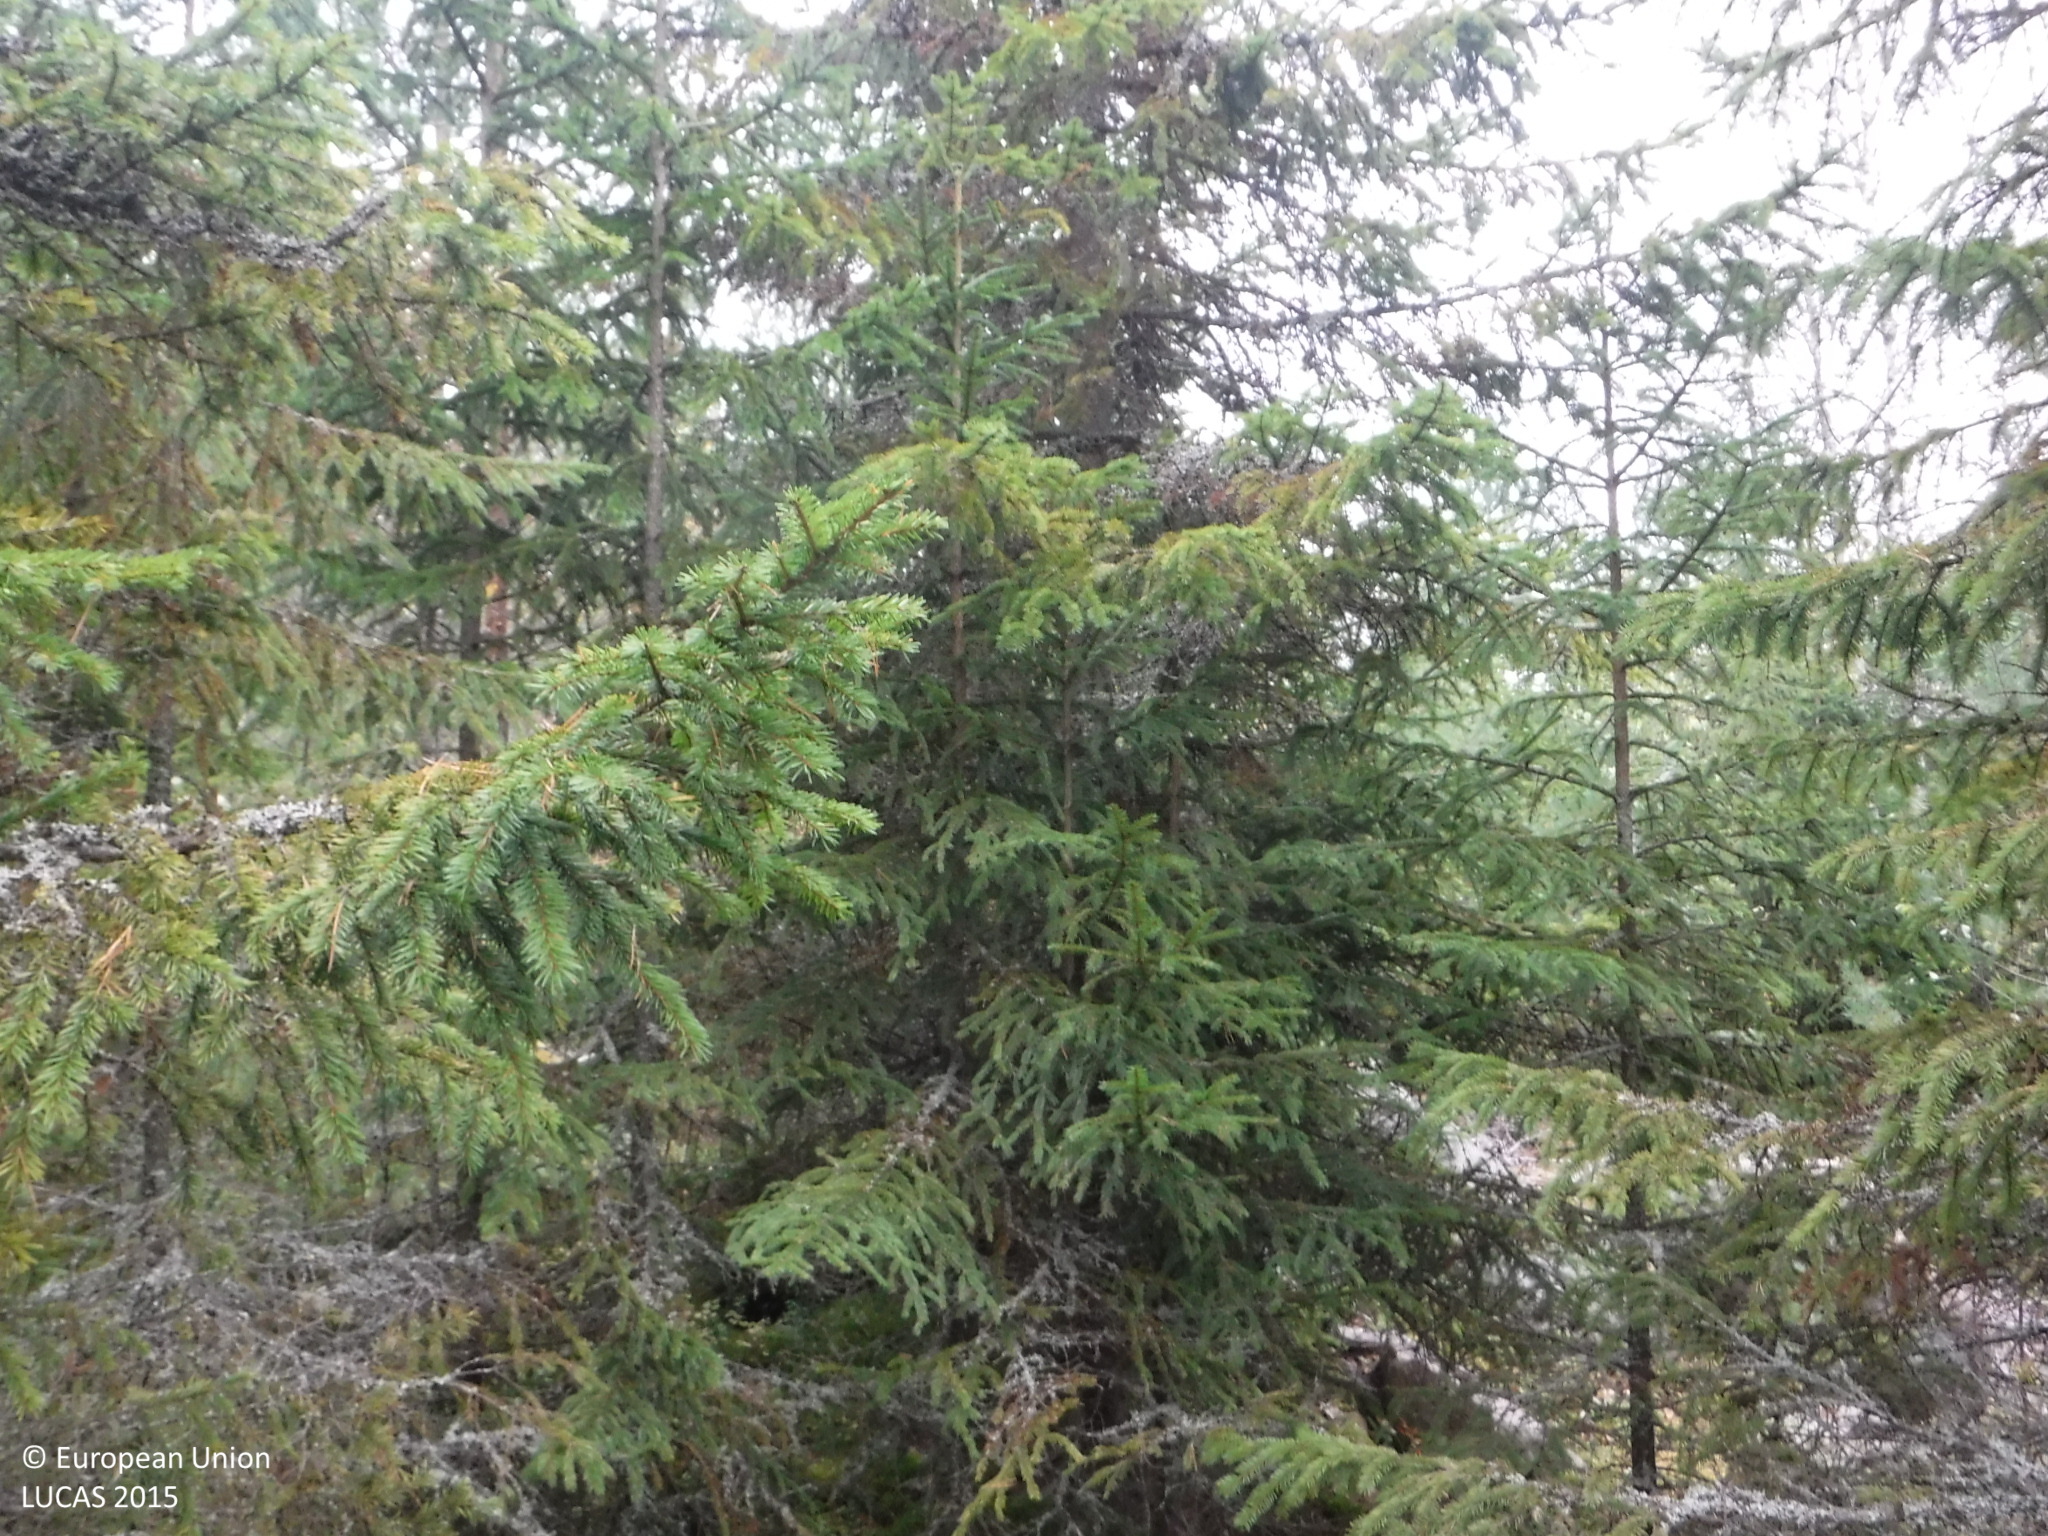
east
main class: Woodland
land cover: Other coniferous woodland
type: boreal forest
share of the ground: 50 - 75 %
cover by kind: coniferous forest trees 55 %, lichens and mosses 25 %, shrubs 20 %
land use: Forestry
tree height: > 5 m
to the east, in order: Other coniferous woodland; Spruce dominated coniferous woodland; Other mixed woodland; Spruce dominated mixed woodland; Rivers and streams; Broadleaved woodland; Pine dominated mixed woodland
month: September
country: FI
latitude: 61.5752
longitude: 23.9282
